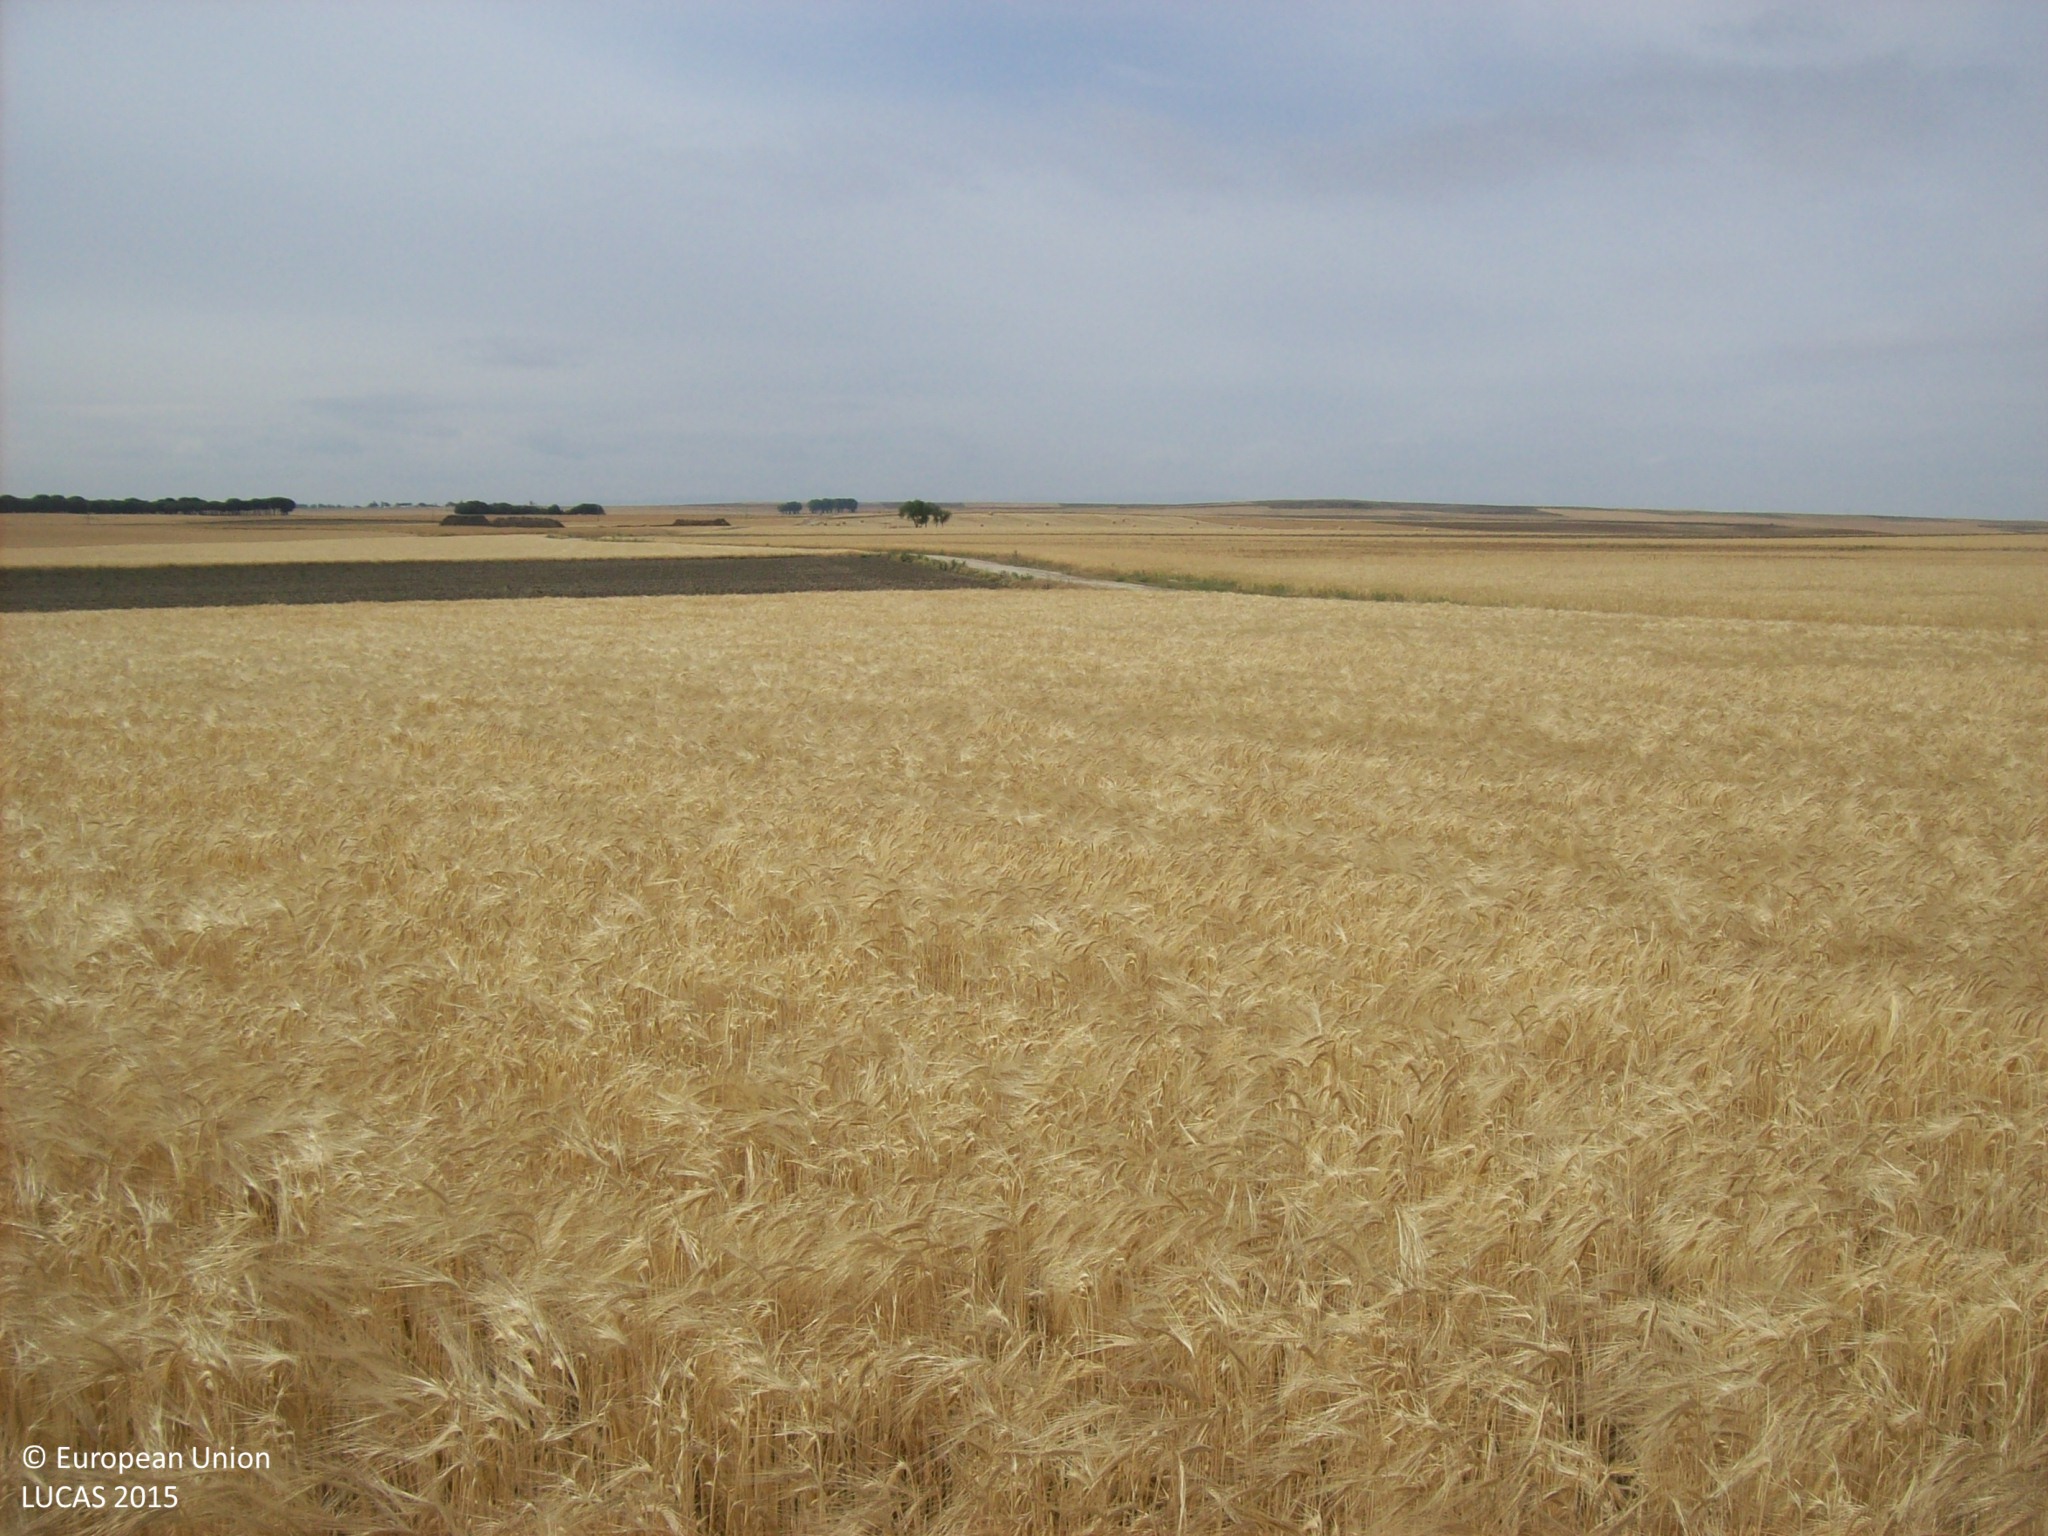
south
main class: Cropland
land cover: Barley
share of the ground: > 75 %
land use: Agriculture (excluding fallow land and kitchen gardens)
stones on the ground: < 10 %
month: June
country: ES
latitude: 41.0389
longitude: -4.9704
